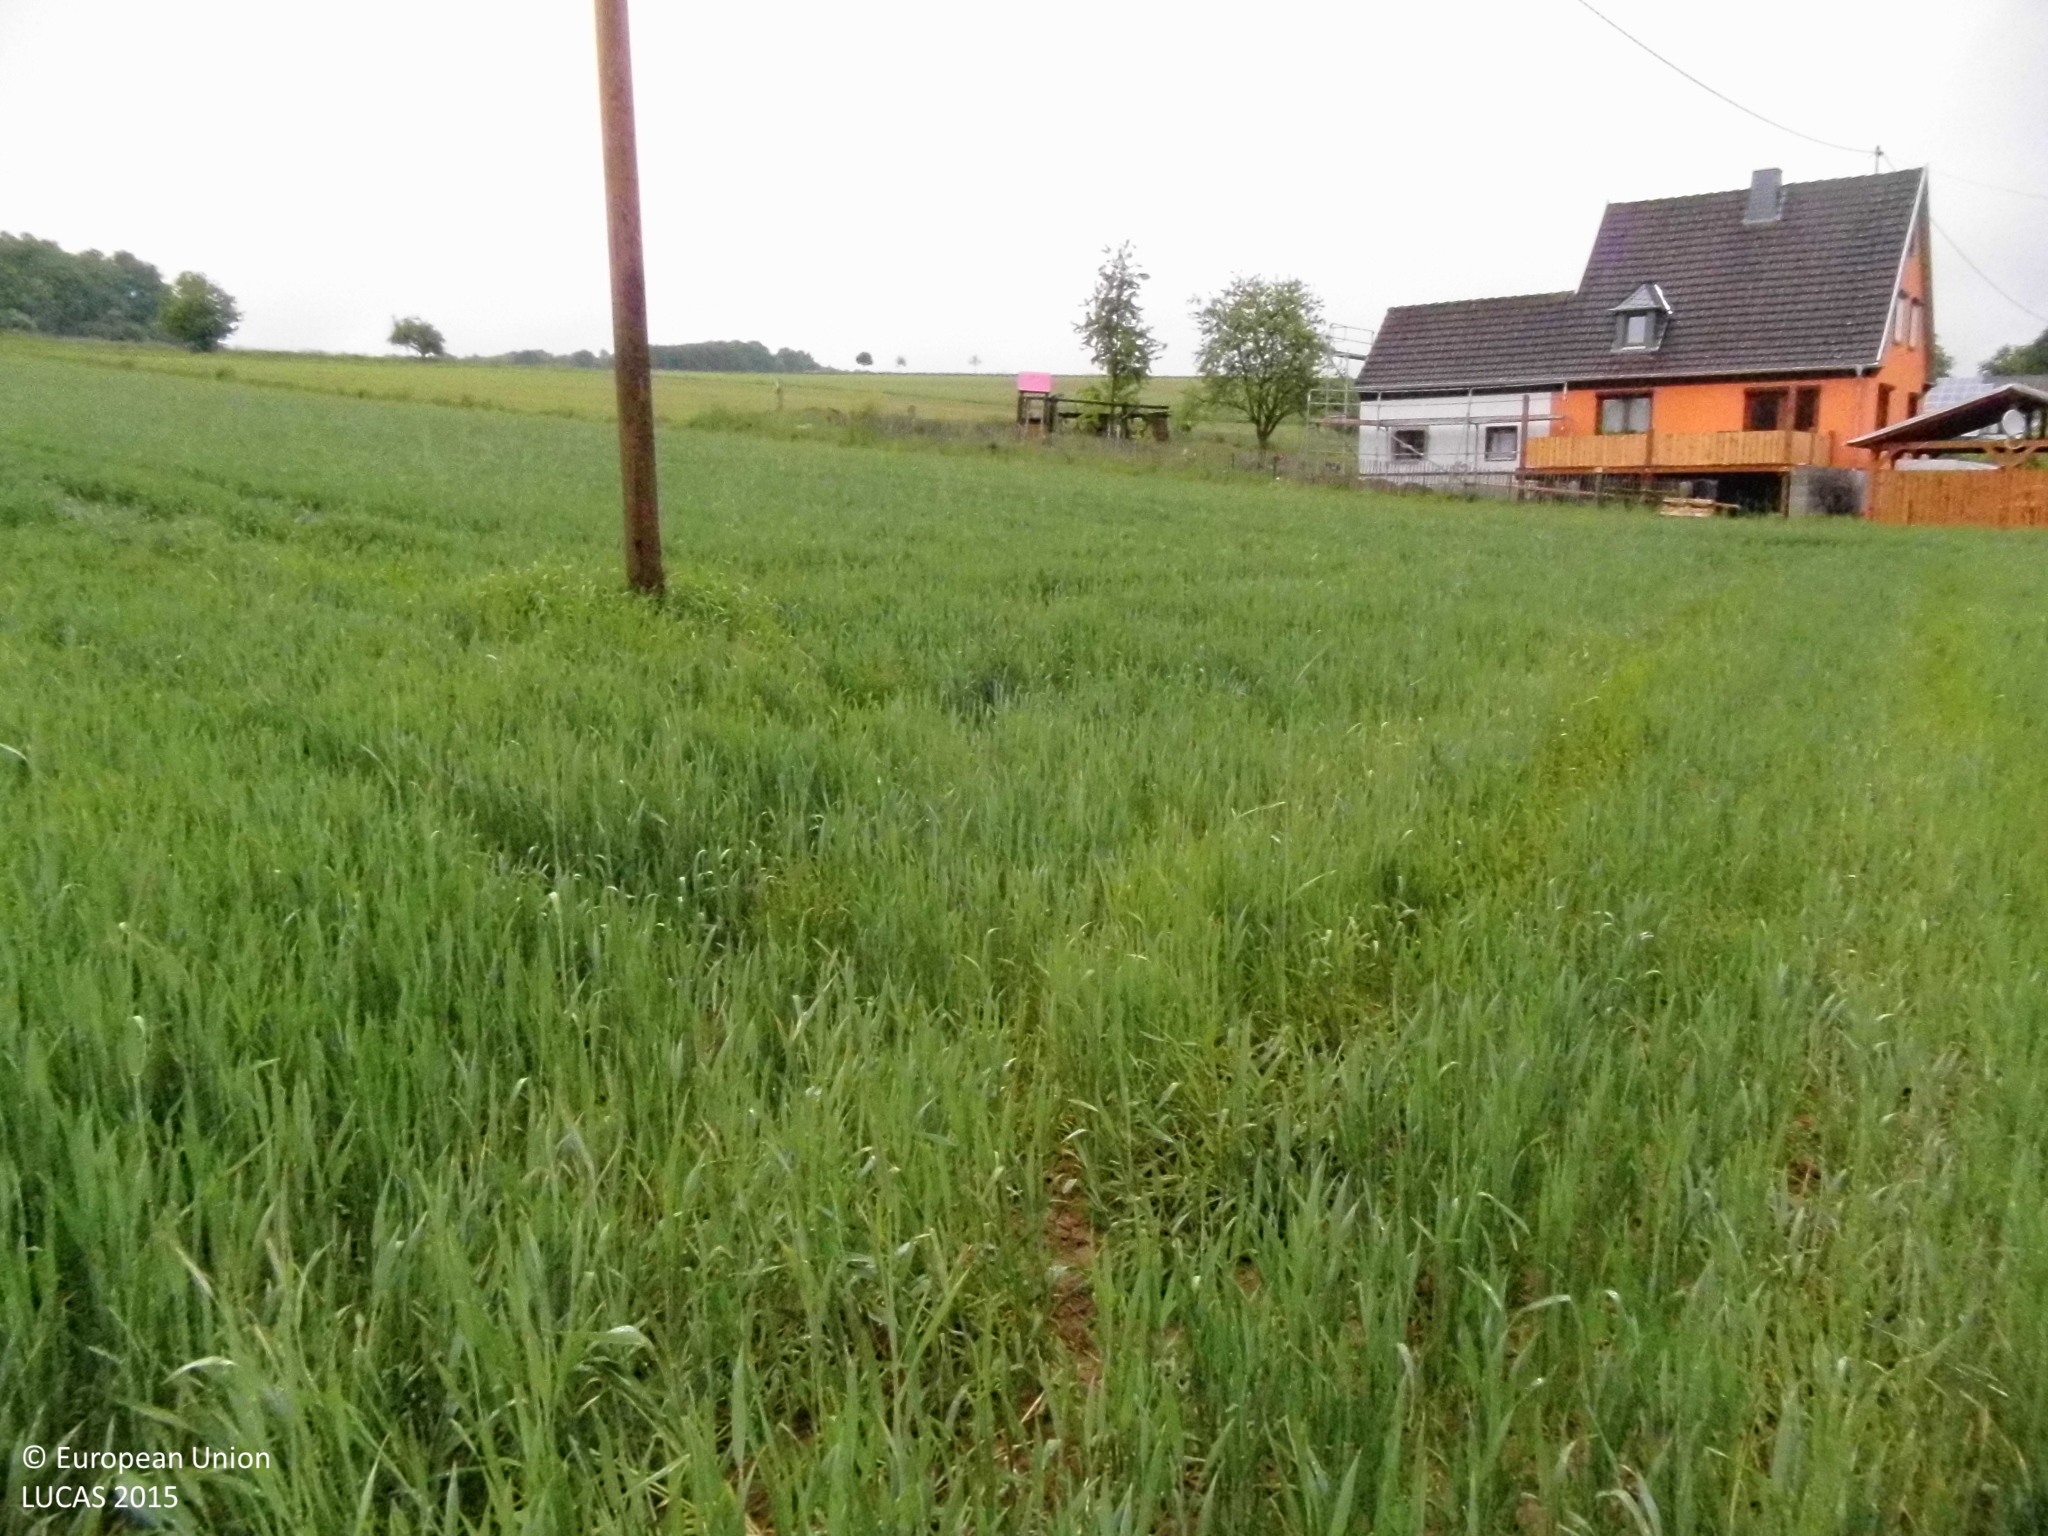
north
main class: Cropland
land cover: Common wheat
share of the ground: > 75 %
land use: Agriculture (excluding fallow land and kitchen gardens)
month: May
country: DE
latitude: 50.6970
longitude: 7.5227
